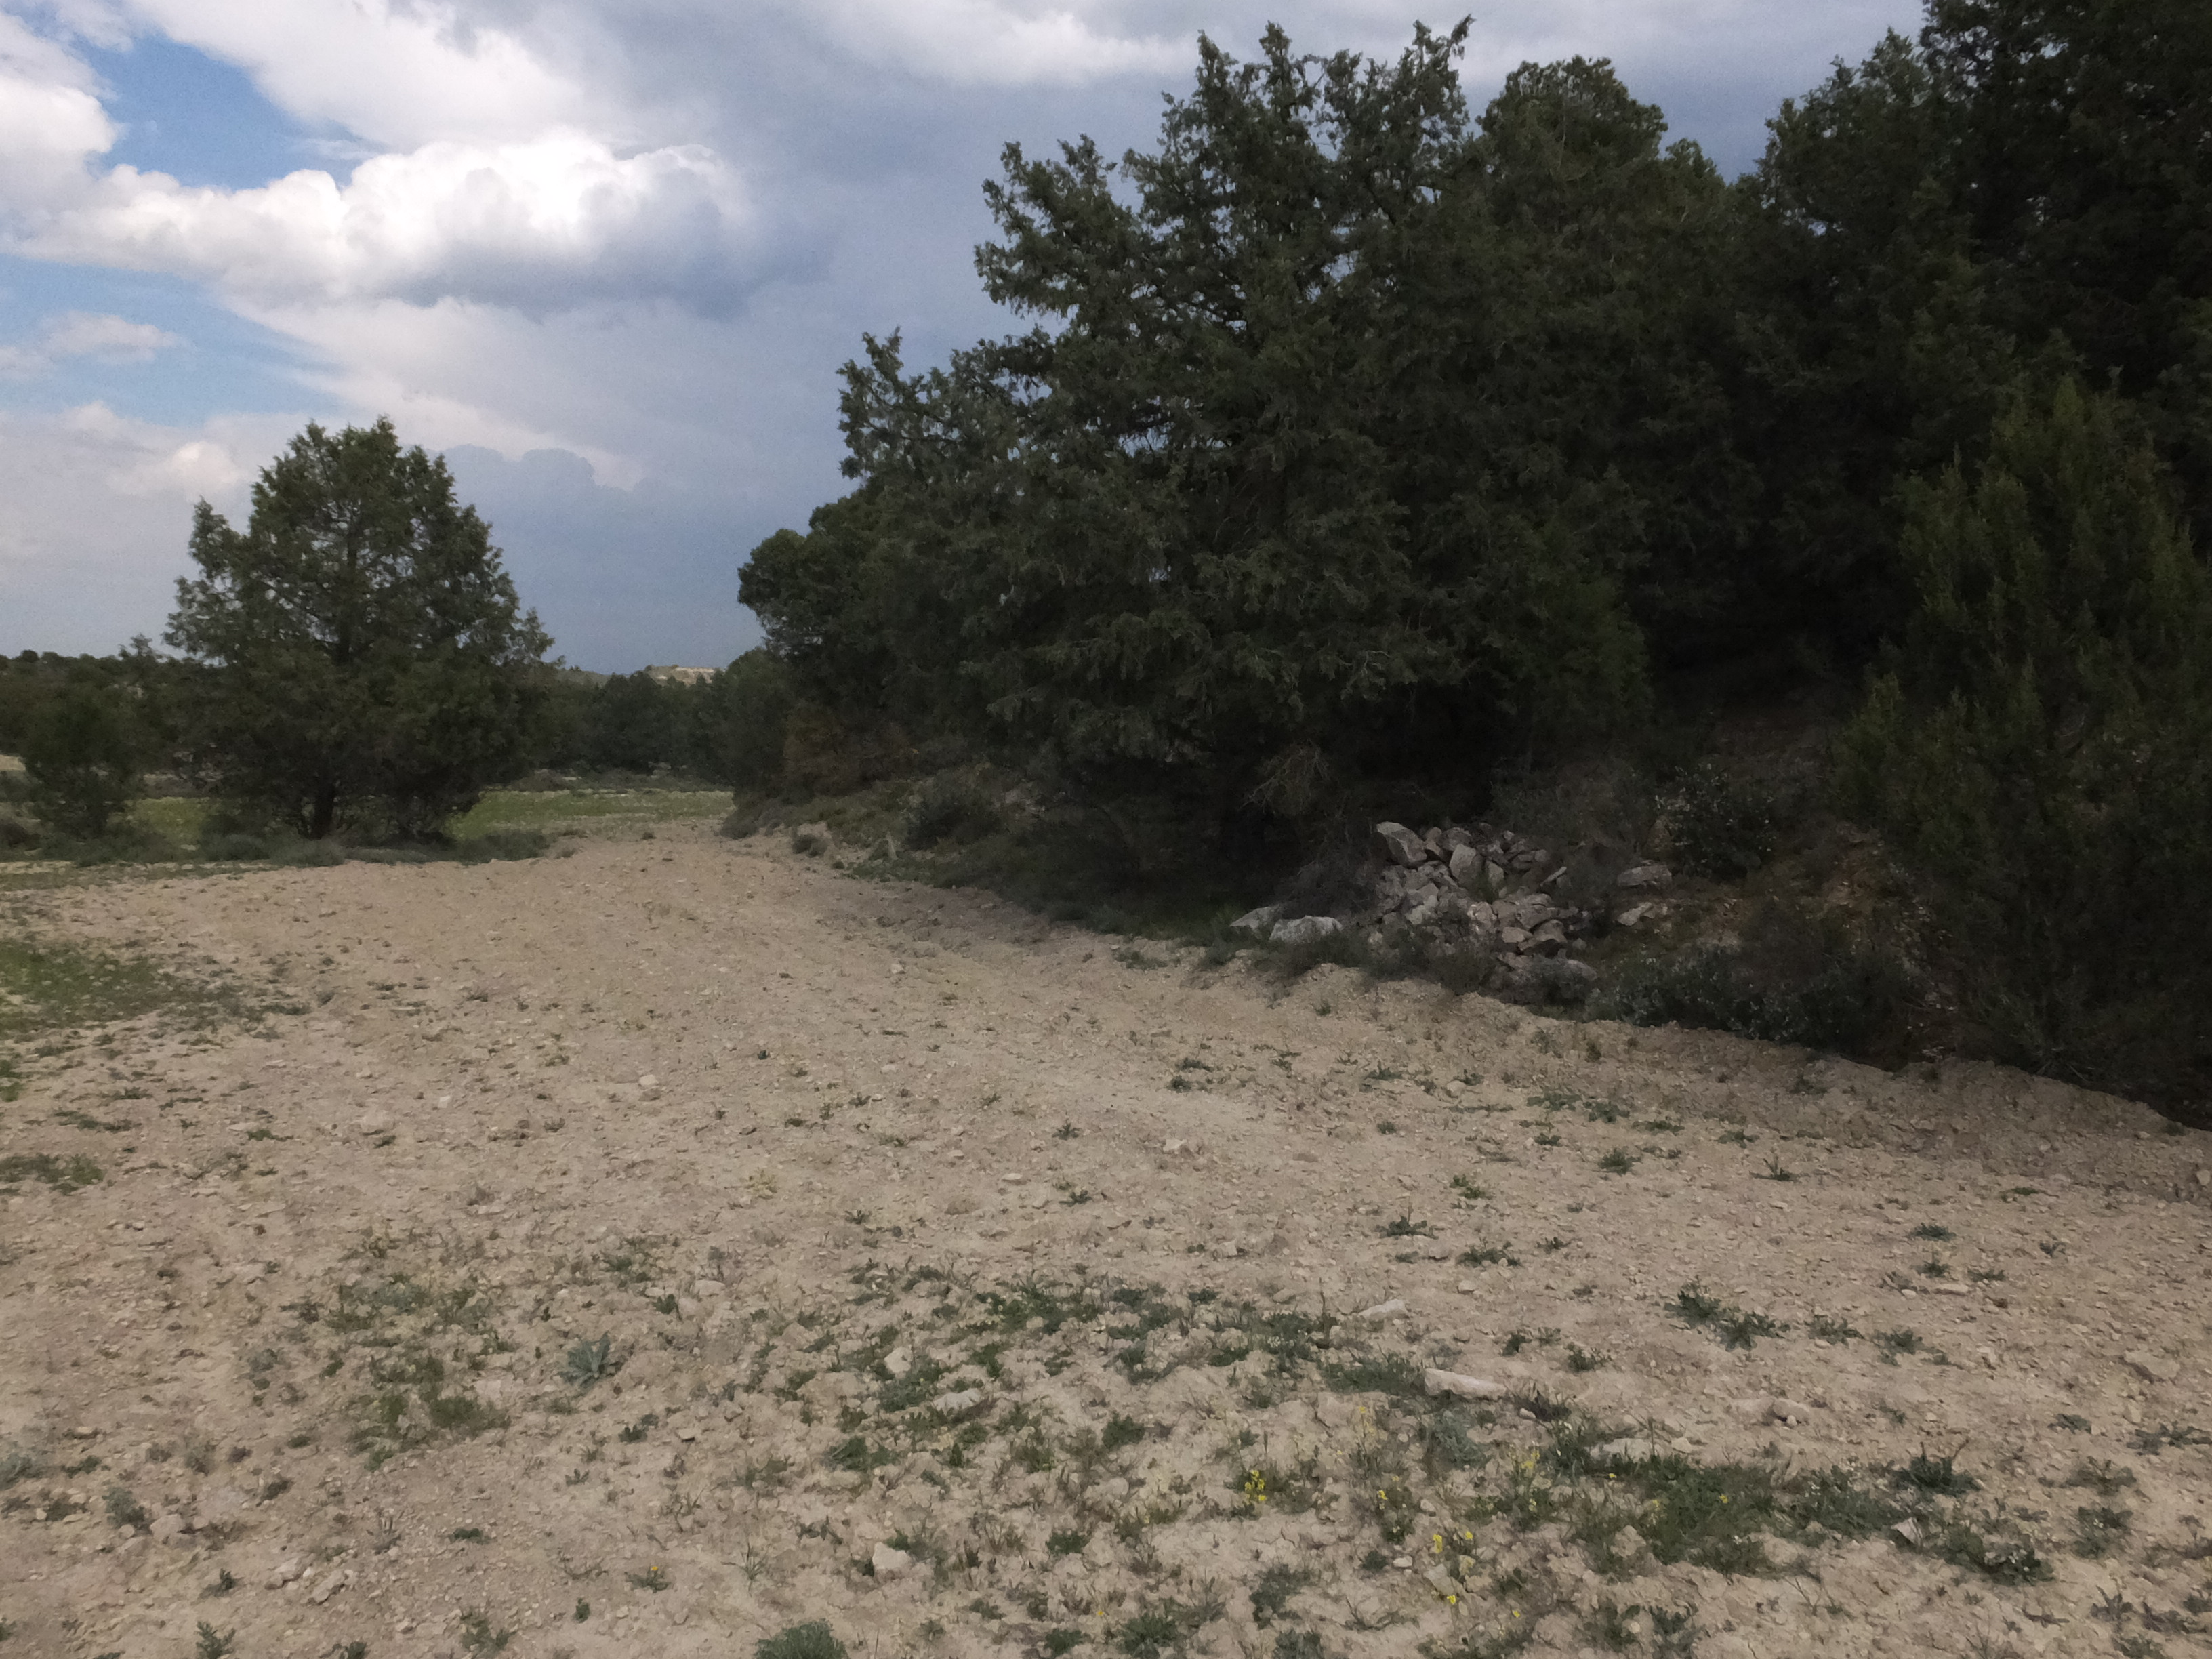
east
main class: Grassland
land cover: Spontaneously vegetated surfaces
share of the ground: 50 - 75 %
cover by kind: herbaceous plants 50 %, unconsolidated bare surface 50 %
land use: Agriculture (excluding fallow land and kitchen gardens)
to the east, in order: Spontaneously vegetated surfaces; Broadleaved woodland; Grassland without tree/shrub cover; Pine dominated mixed woodland; Grassland without tree/shrub cover; Pine dominated mixed woodland; Rock outcrops; Shrubland with sparse tree cover
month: April
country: ES
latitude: 41.7177
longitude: -0.3920
